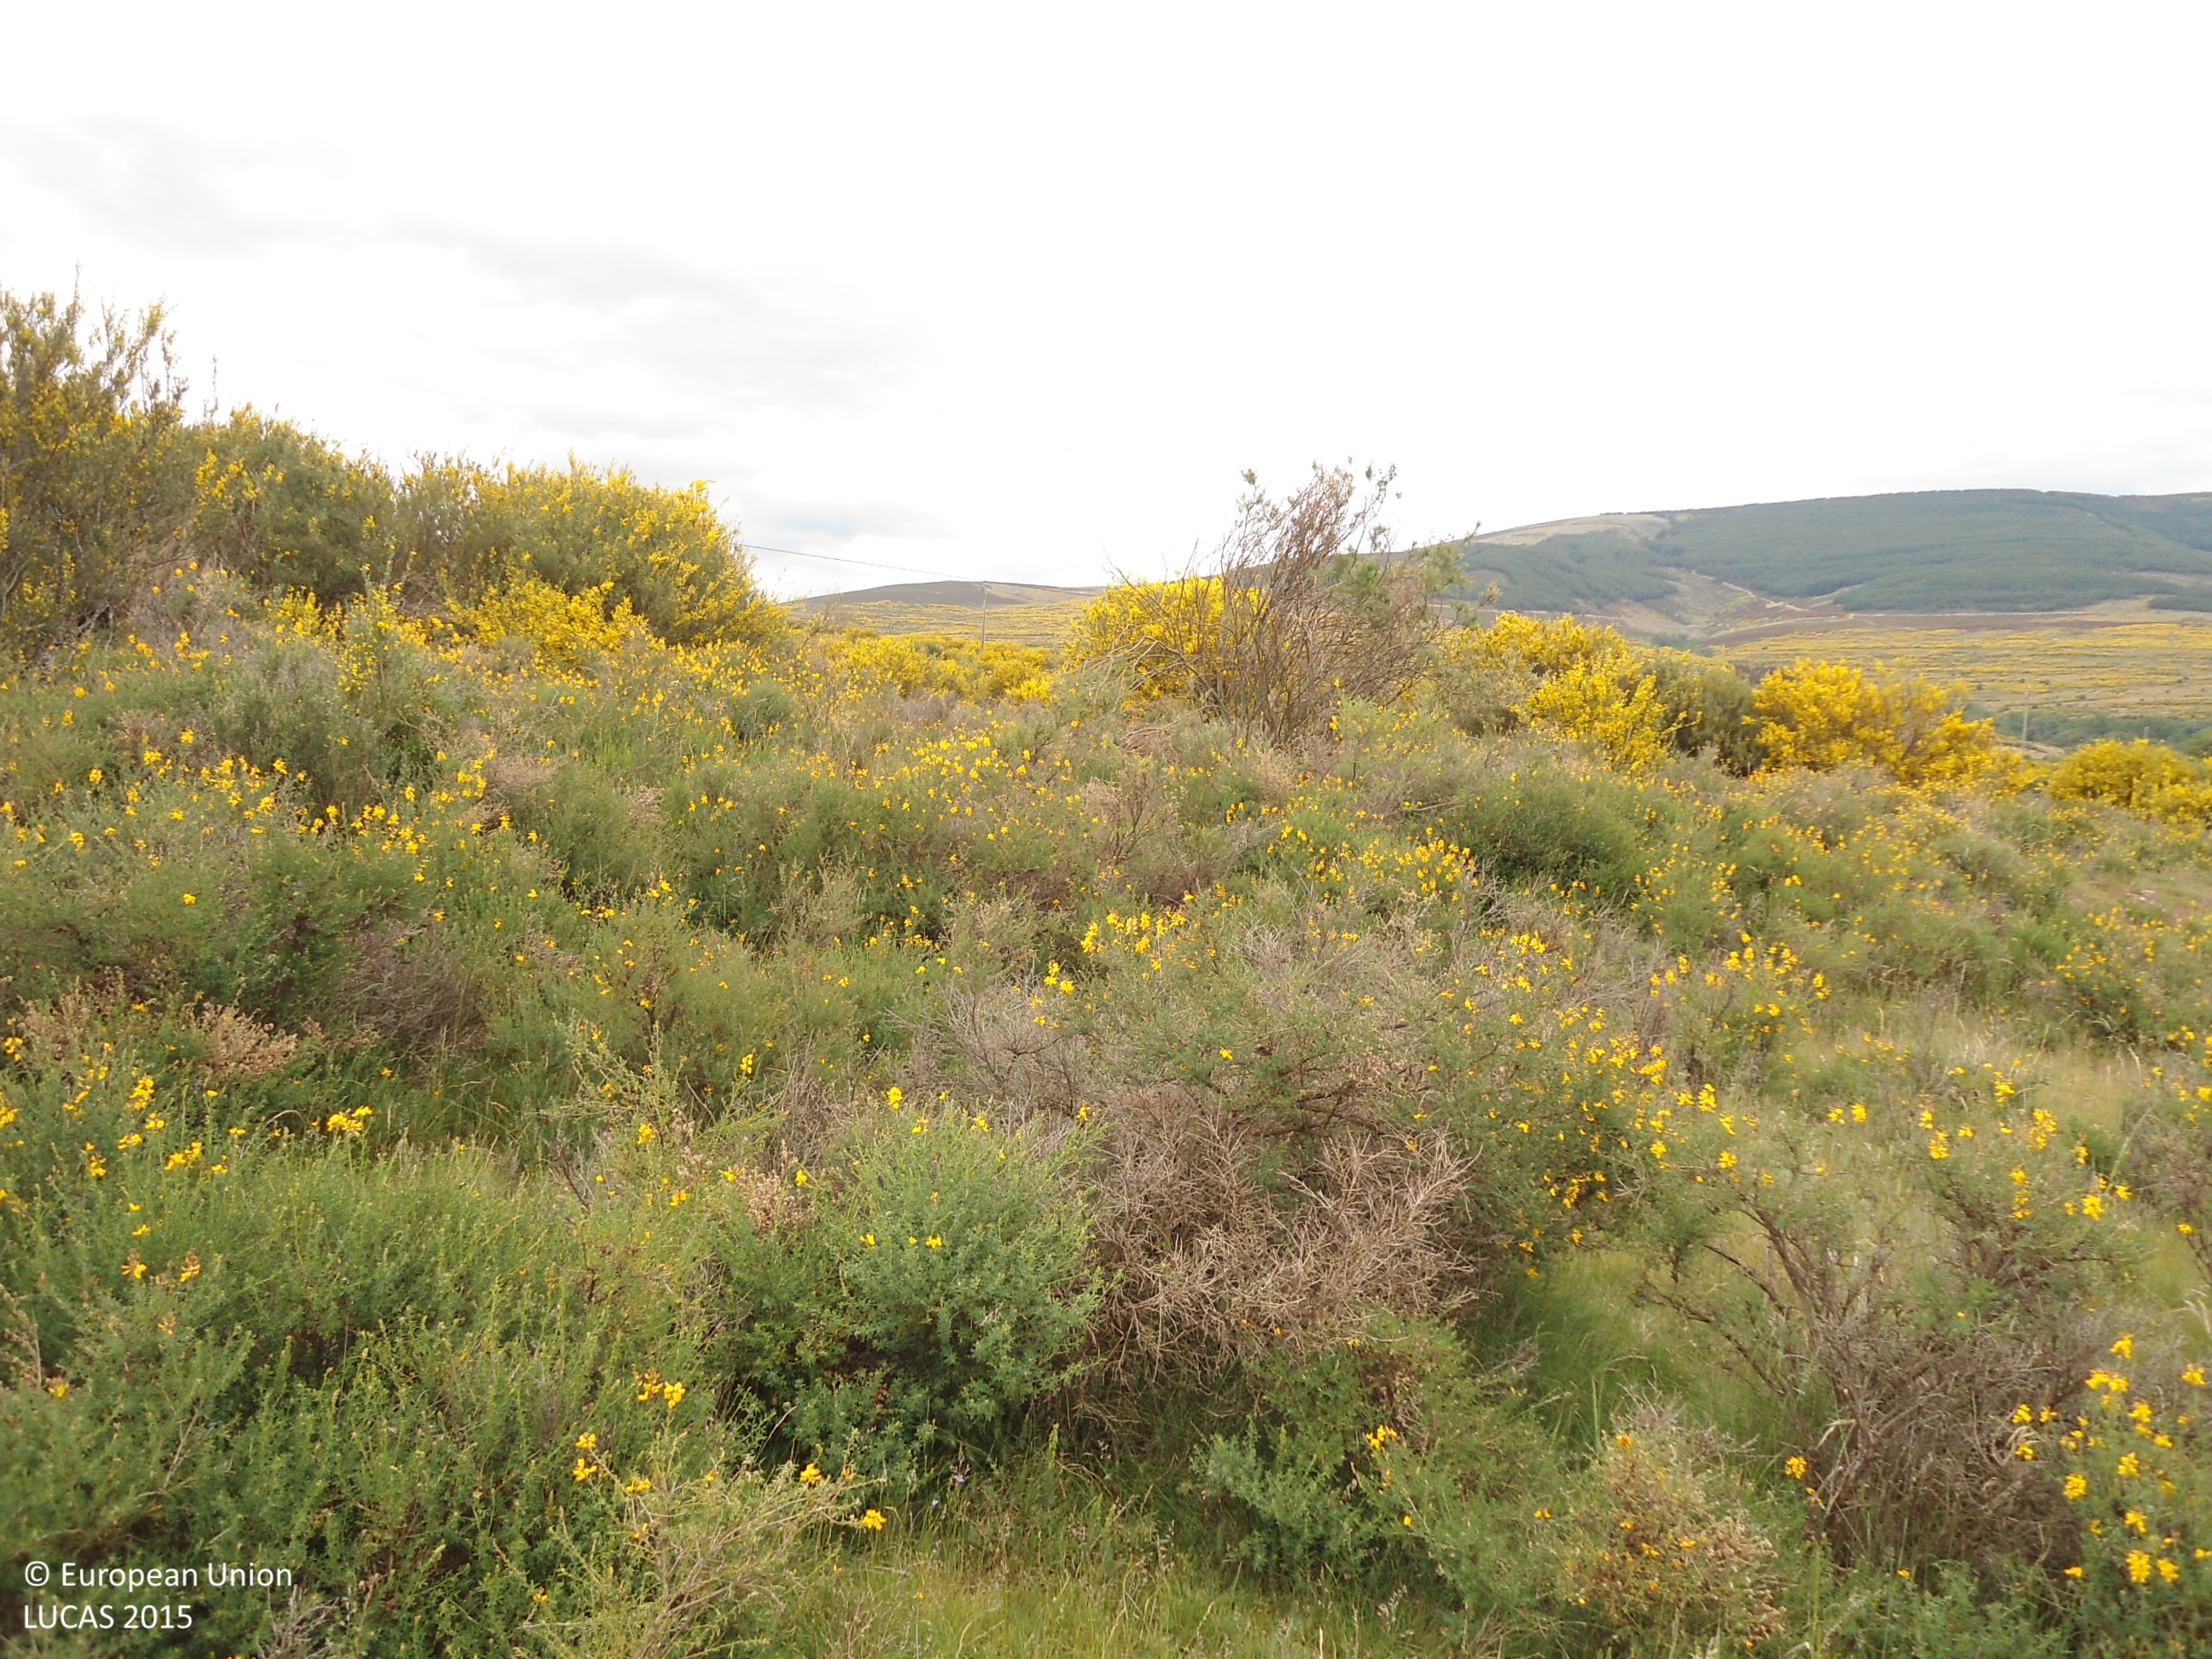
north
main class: Shrubland
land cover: Shrubland without tree cover
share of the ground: > 75 %
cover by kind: shrubs 75 %, herbaceous plants 25 %
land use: Agriculture (excluding fallow land and kitchen gardens)
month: June
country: ES
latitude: 42.2563
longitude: -6.4397
